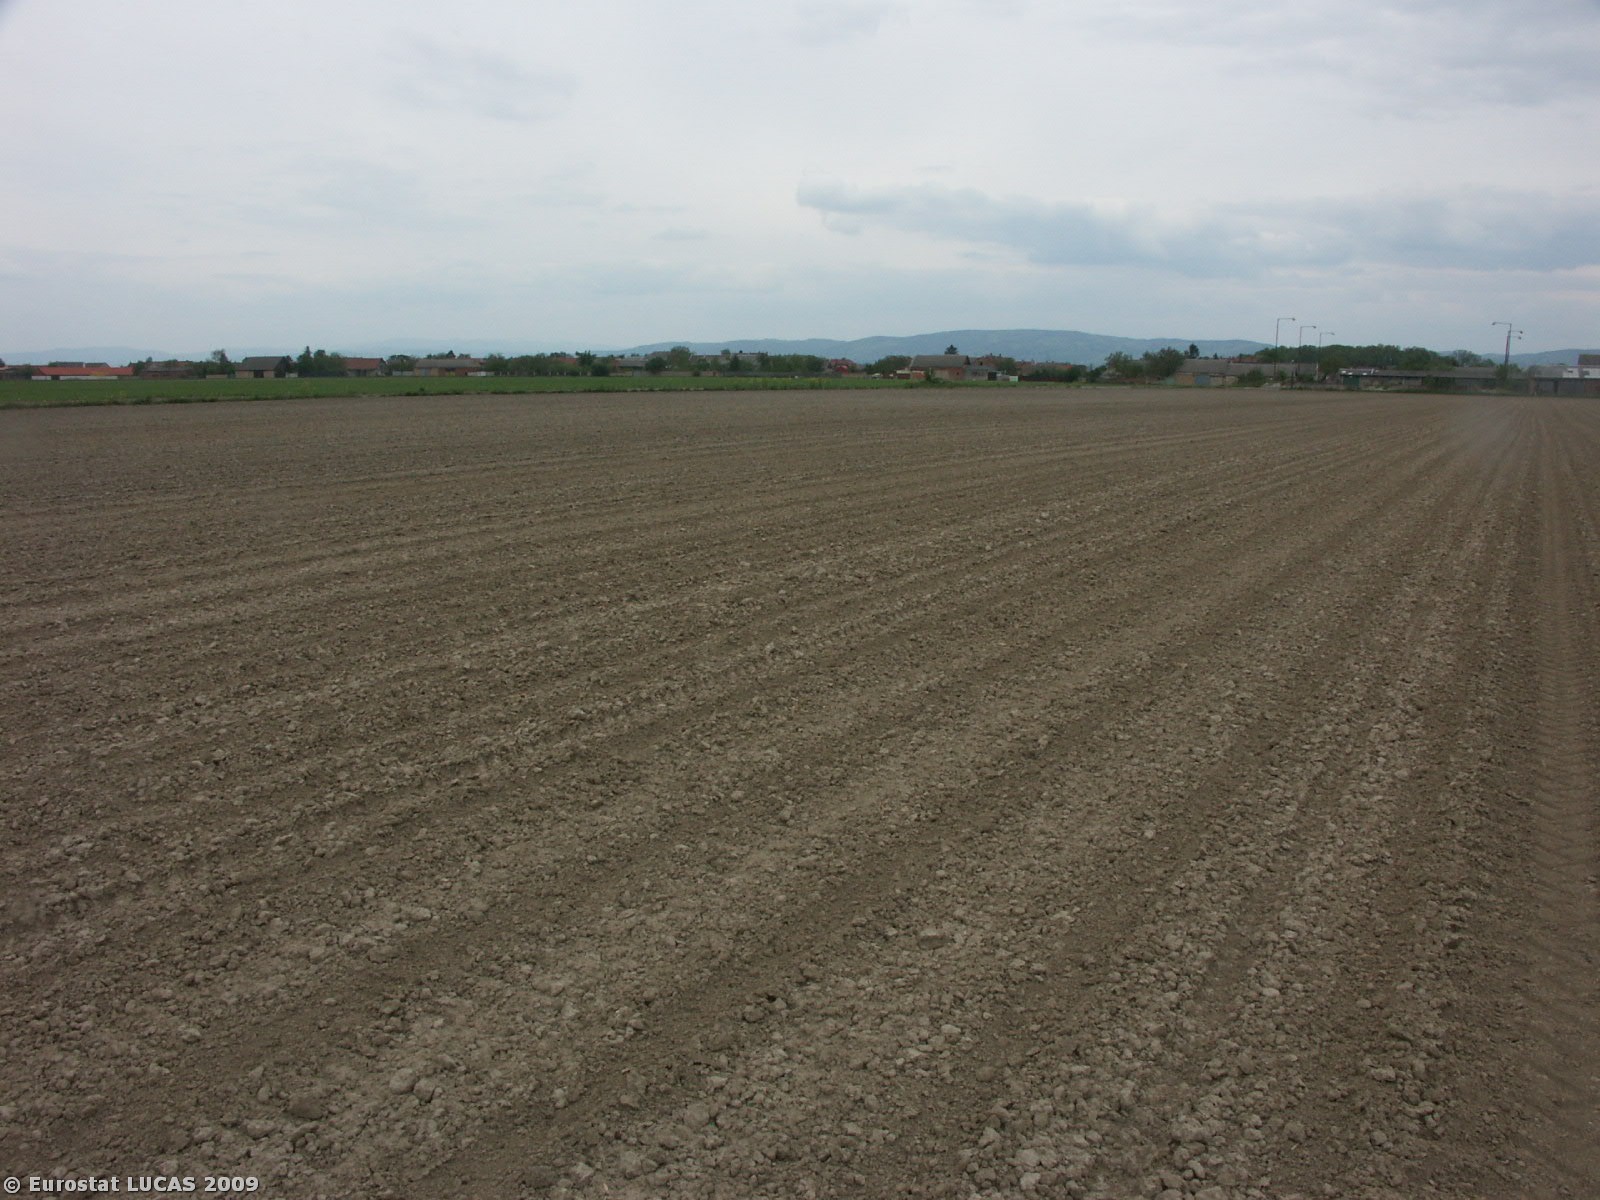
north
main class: Cropland
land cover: Maize
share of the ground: < 10 %
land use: Agriculture (excluding fallow land and kitchen gardens)
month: May
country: CZ
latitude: 49.6854
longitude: 17.2042
